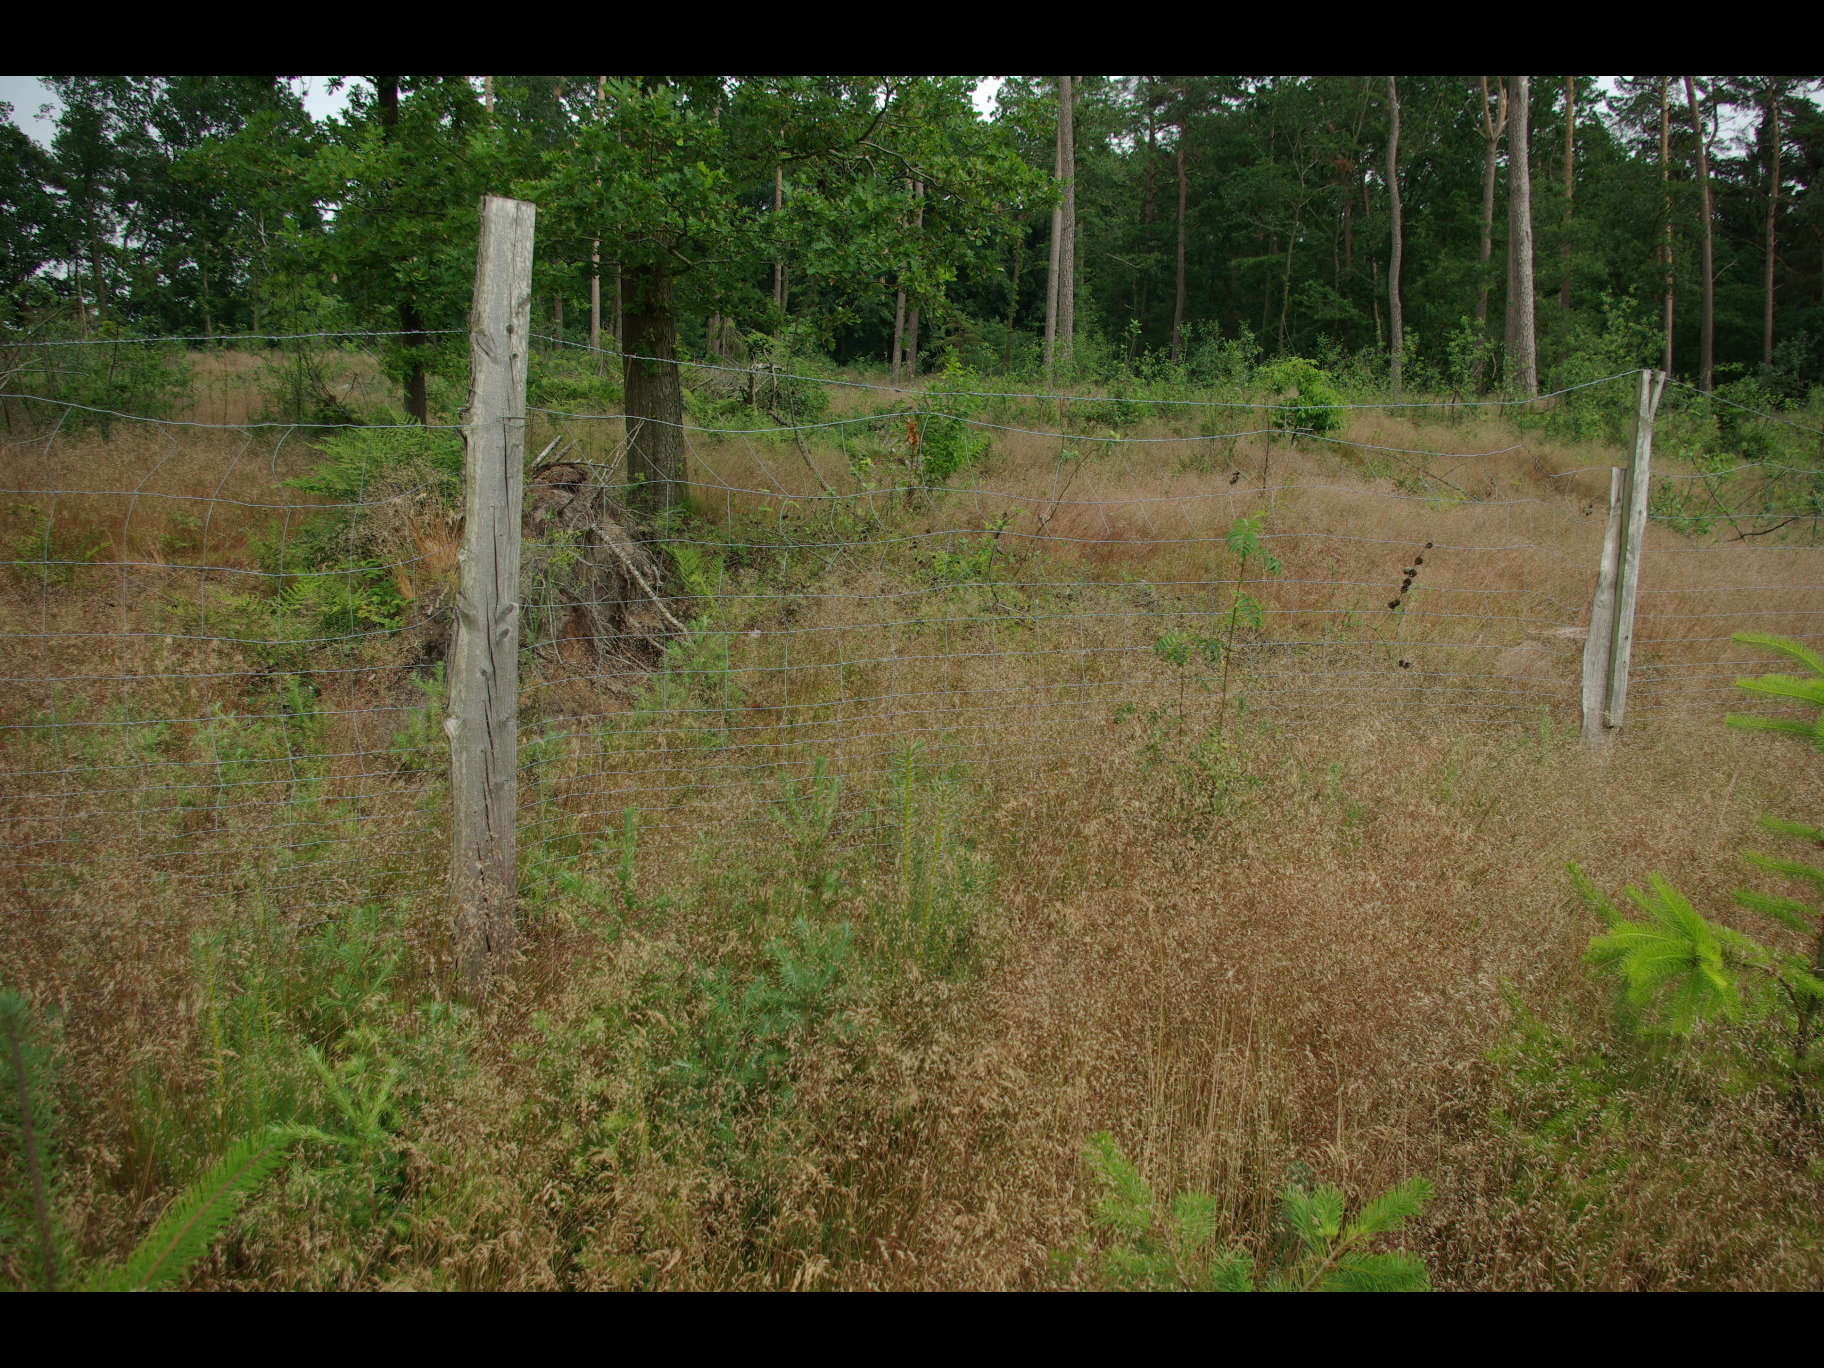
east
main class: Woodland
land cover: Other coniferous woodland
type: hemiboreal forest and nemoral coniferous forest and mixed broadleaved-coniferous forest
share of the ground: 50 - 75 %
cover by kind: coniferous forest trees 50 %, herbaceous plants 40 %, broadleaved forest trees 5 %, shrubs 5 %
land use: Forestry
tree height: < 5 m
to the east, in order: Other coniferous woodland; Fences; Other mixed woodland; Groves; Grass margins; Paved roads, cycling and walking lanes; Spontaneously vegetated surfaces; Broadleaved woodland; Grassland without tree/shrub cover; Broadleaved woodland
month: July
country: DE
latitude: 54.1922
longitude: 9.6477
